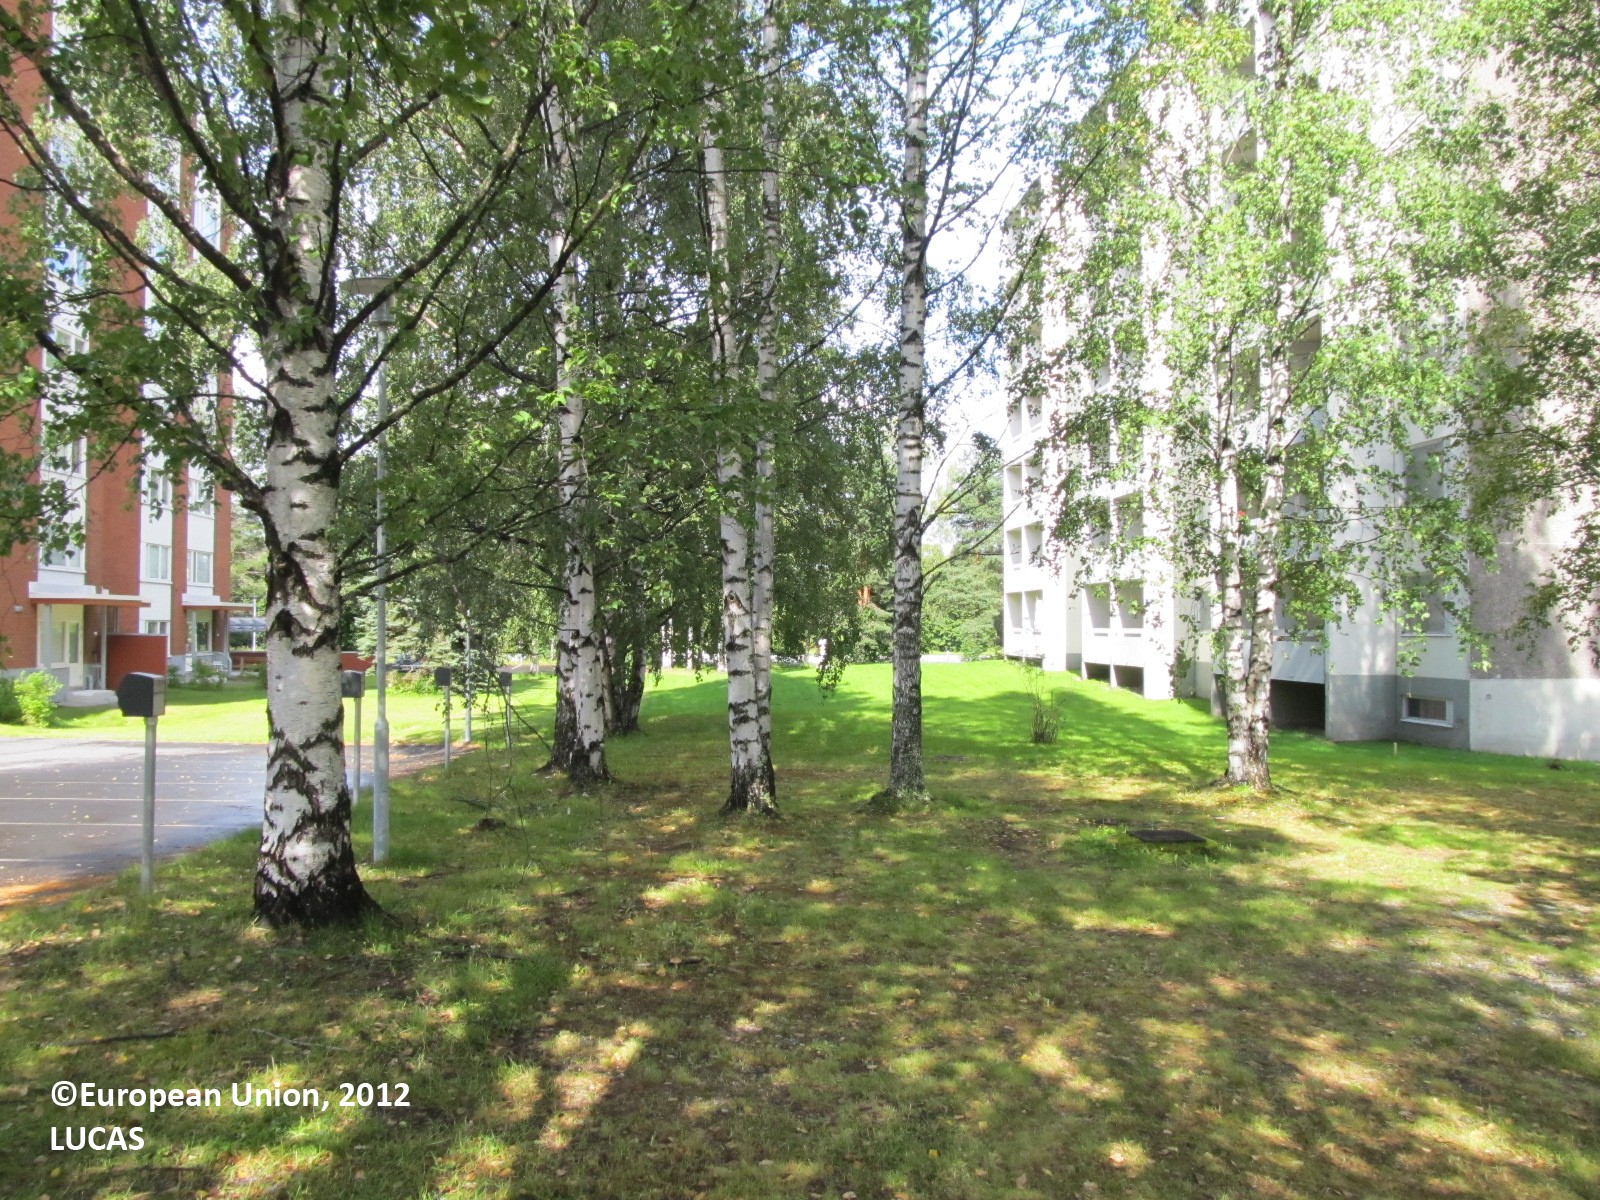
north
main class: Woodland
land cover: Broadleaved woodland
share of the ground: 10 - 25 %
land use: Residential
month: August
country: FI
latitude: 62.9057
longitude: 27.7044
